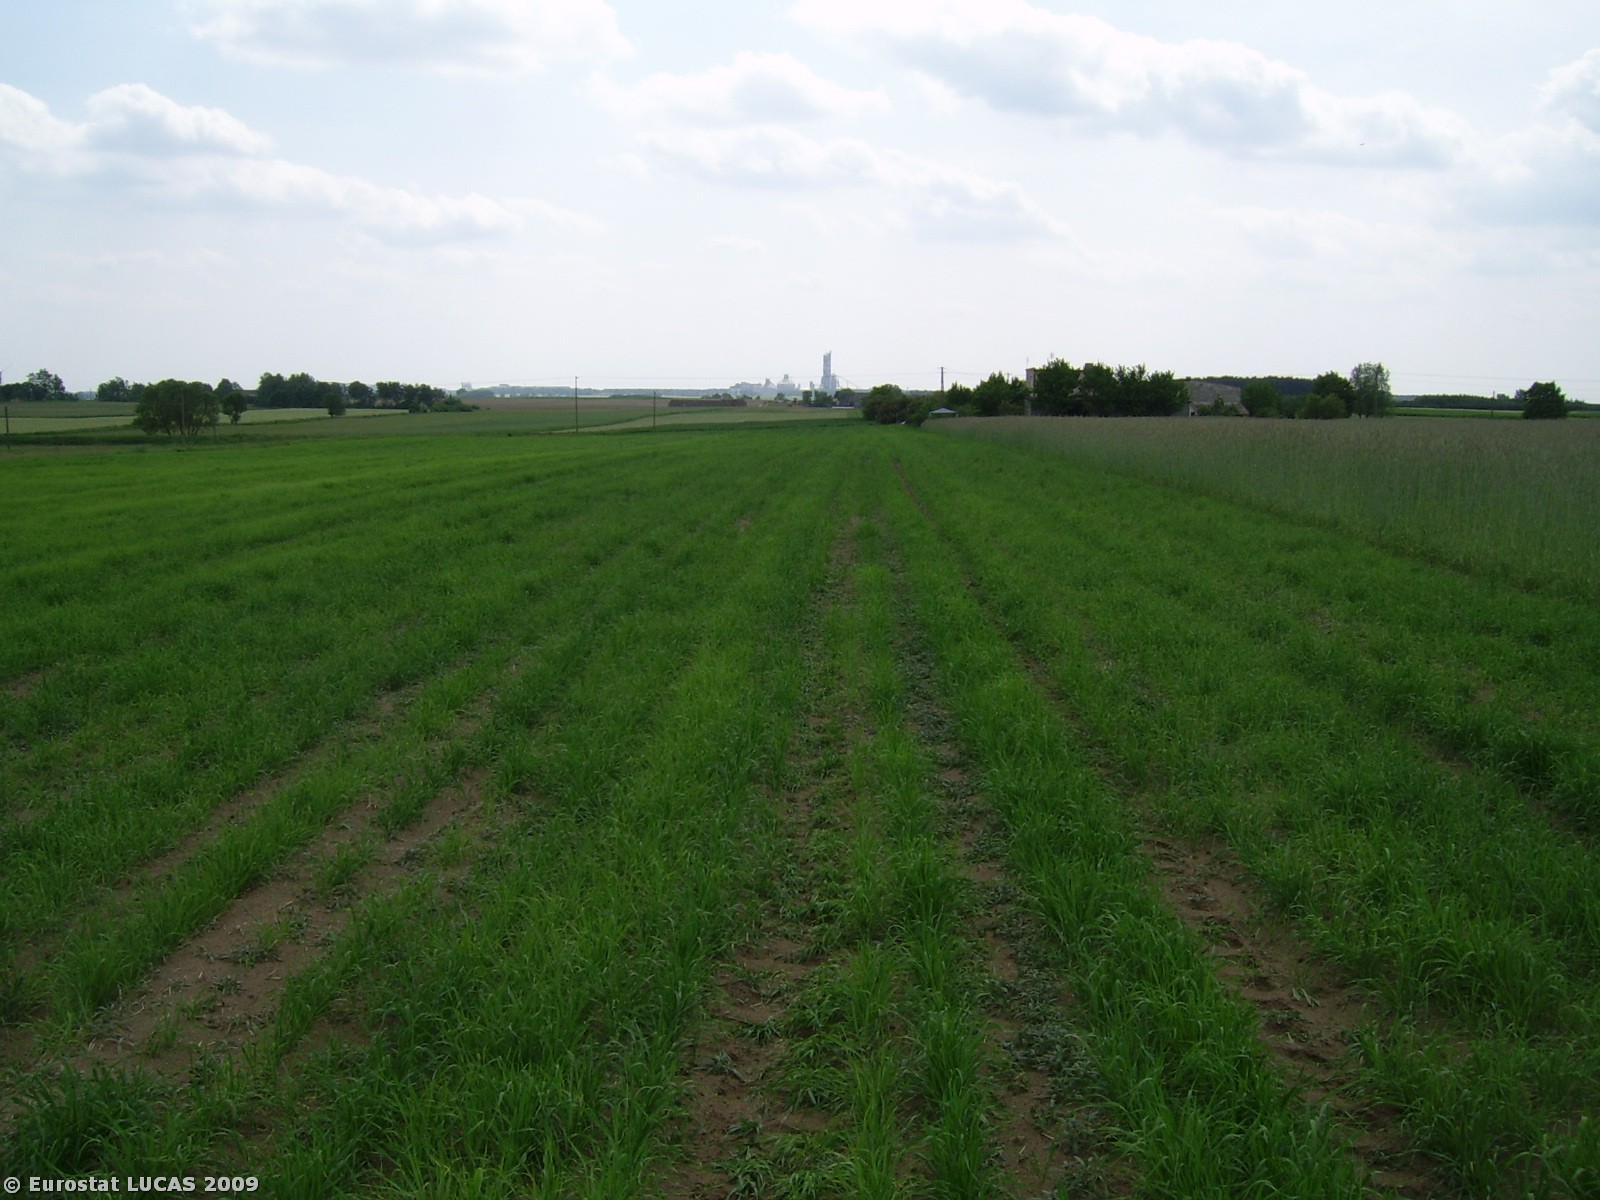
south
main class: Cropland
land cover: Barley
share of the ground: 50 - 75 %
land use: Agriculture (excluding fallow land and kitchen gardens)
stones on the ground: < 10 %
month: May
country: PL
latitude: 52.8844
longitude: 17.9956
